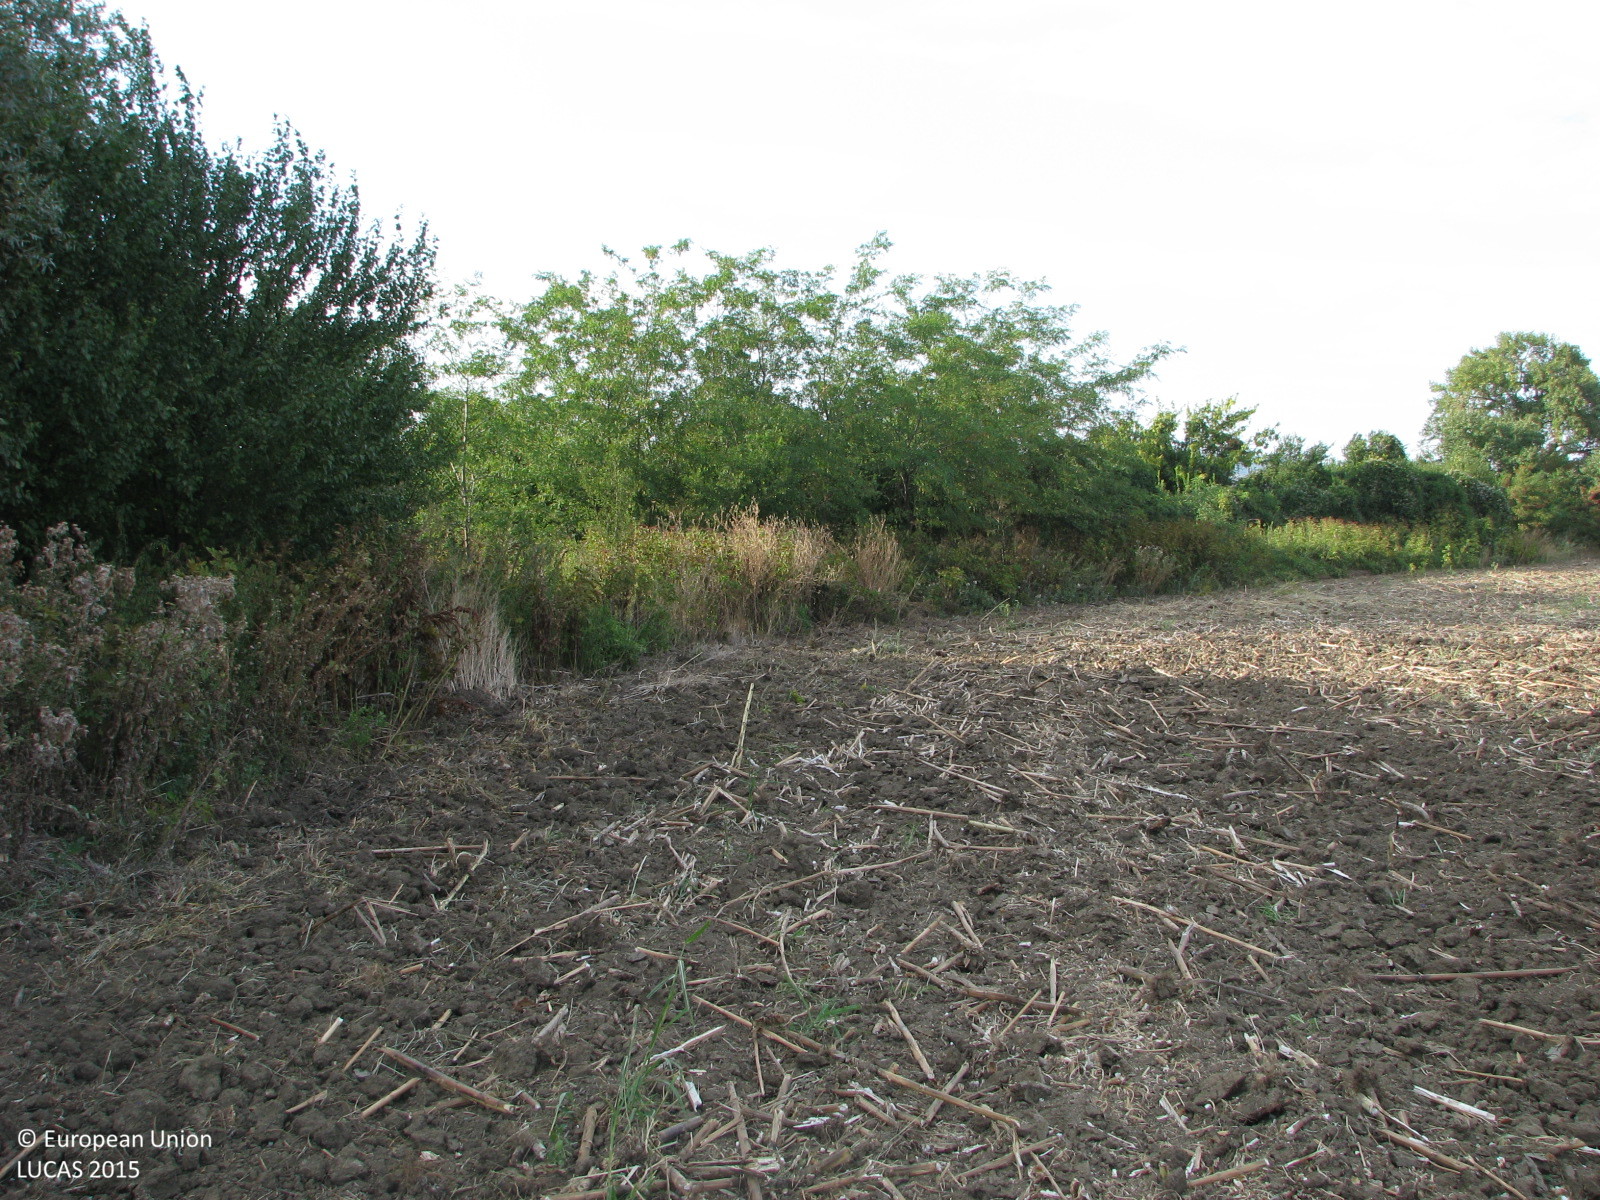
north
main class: Cropland
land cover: Sunflower
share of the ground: < 10 %
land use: Agriculture (excluding fallow land and kitchen gardens)
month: September
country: BG
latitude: 42.5135
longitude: 25.9884
